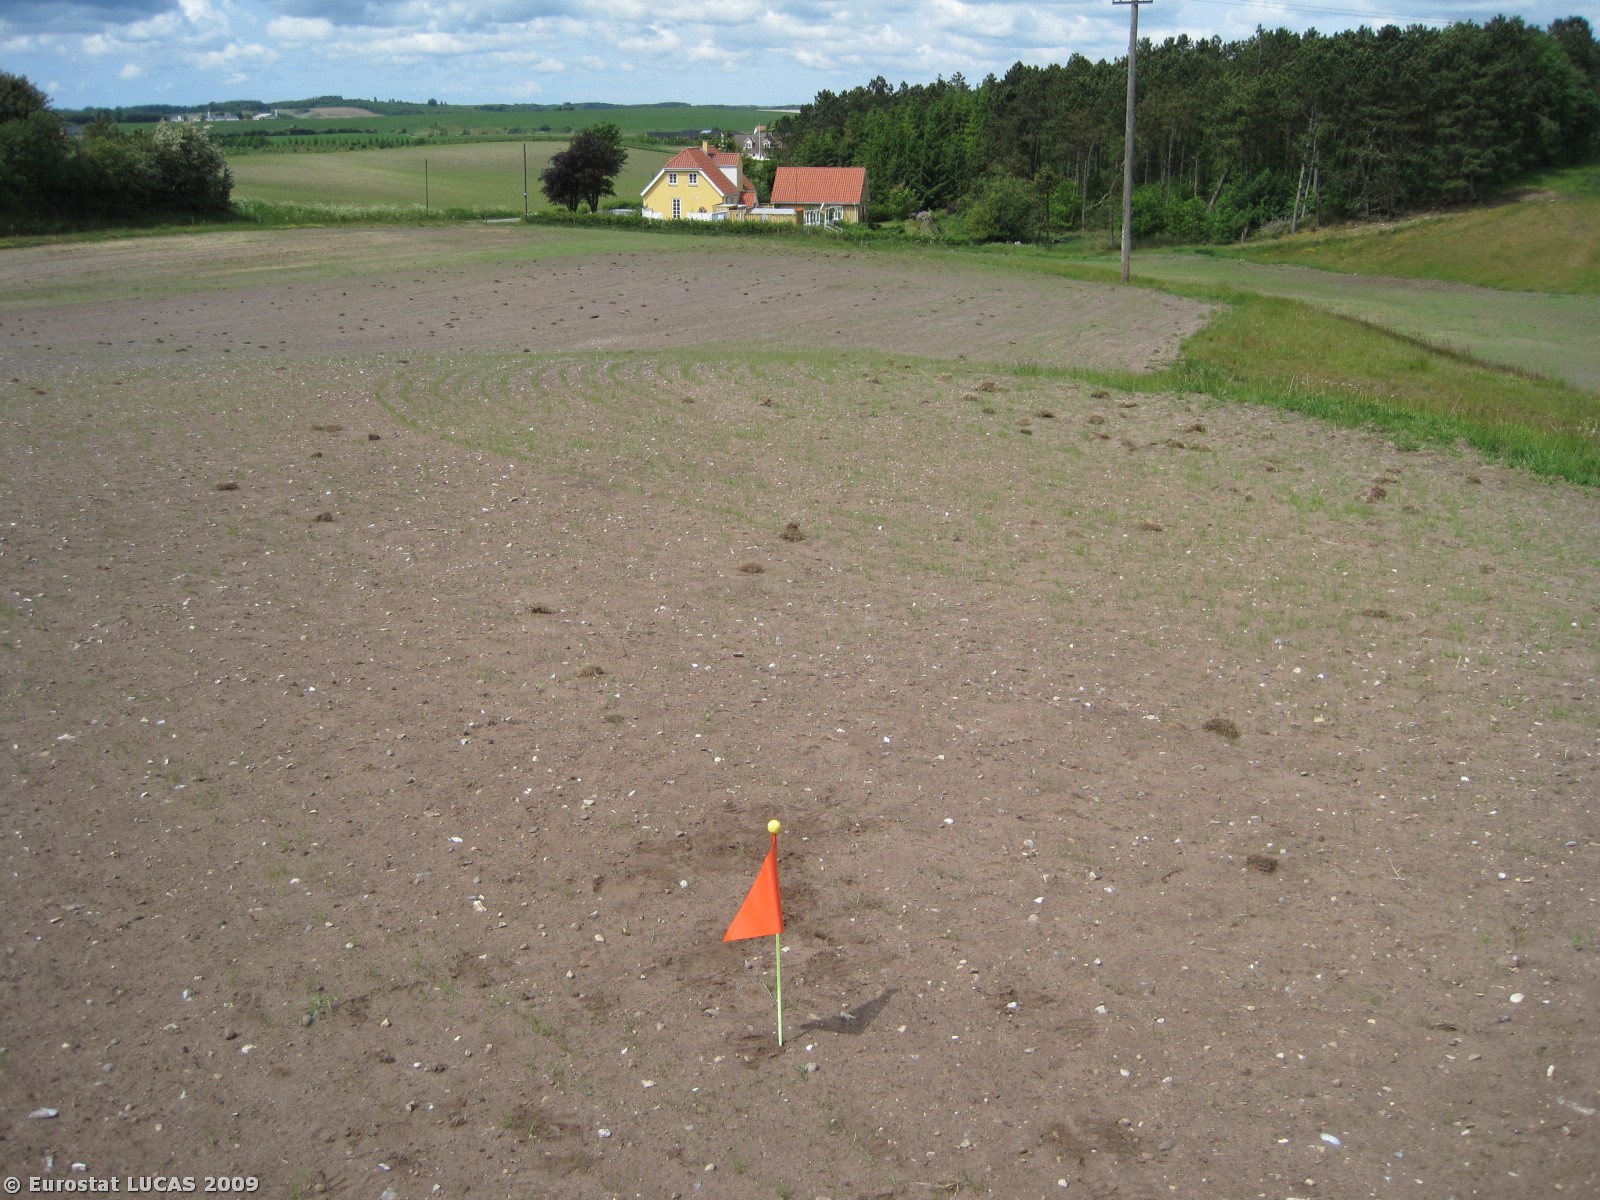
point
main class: Cropland
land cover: Common wheat
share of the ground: < 10 %
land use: Agriculture (excluding fallow land and kitchen gardens)
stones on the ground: 10 - 25 %
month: June
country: DK
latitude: 56.8885
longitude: 9.6886
